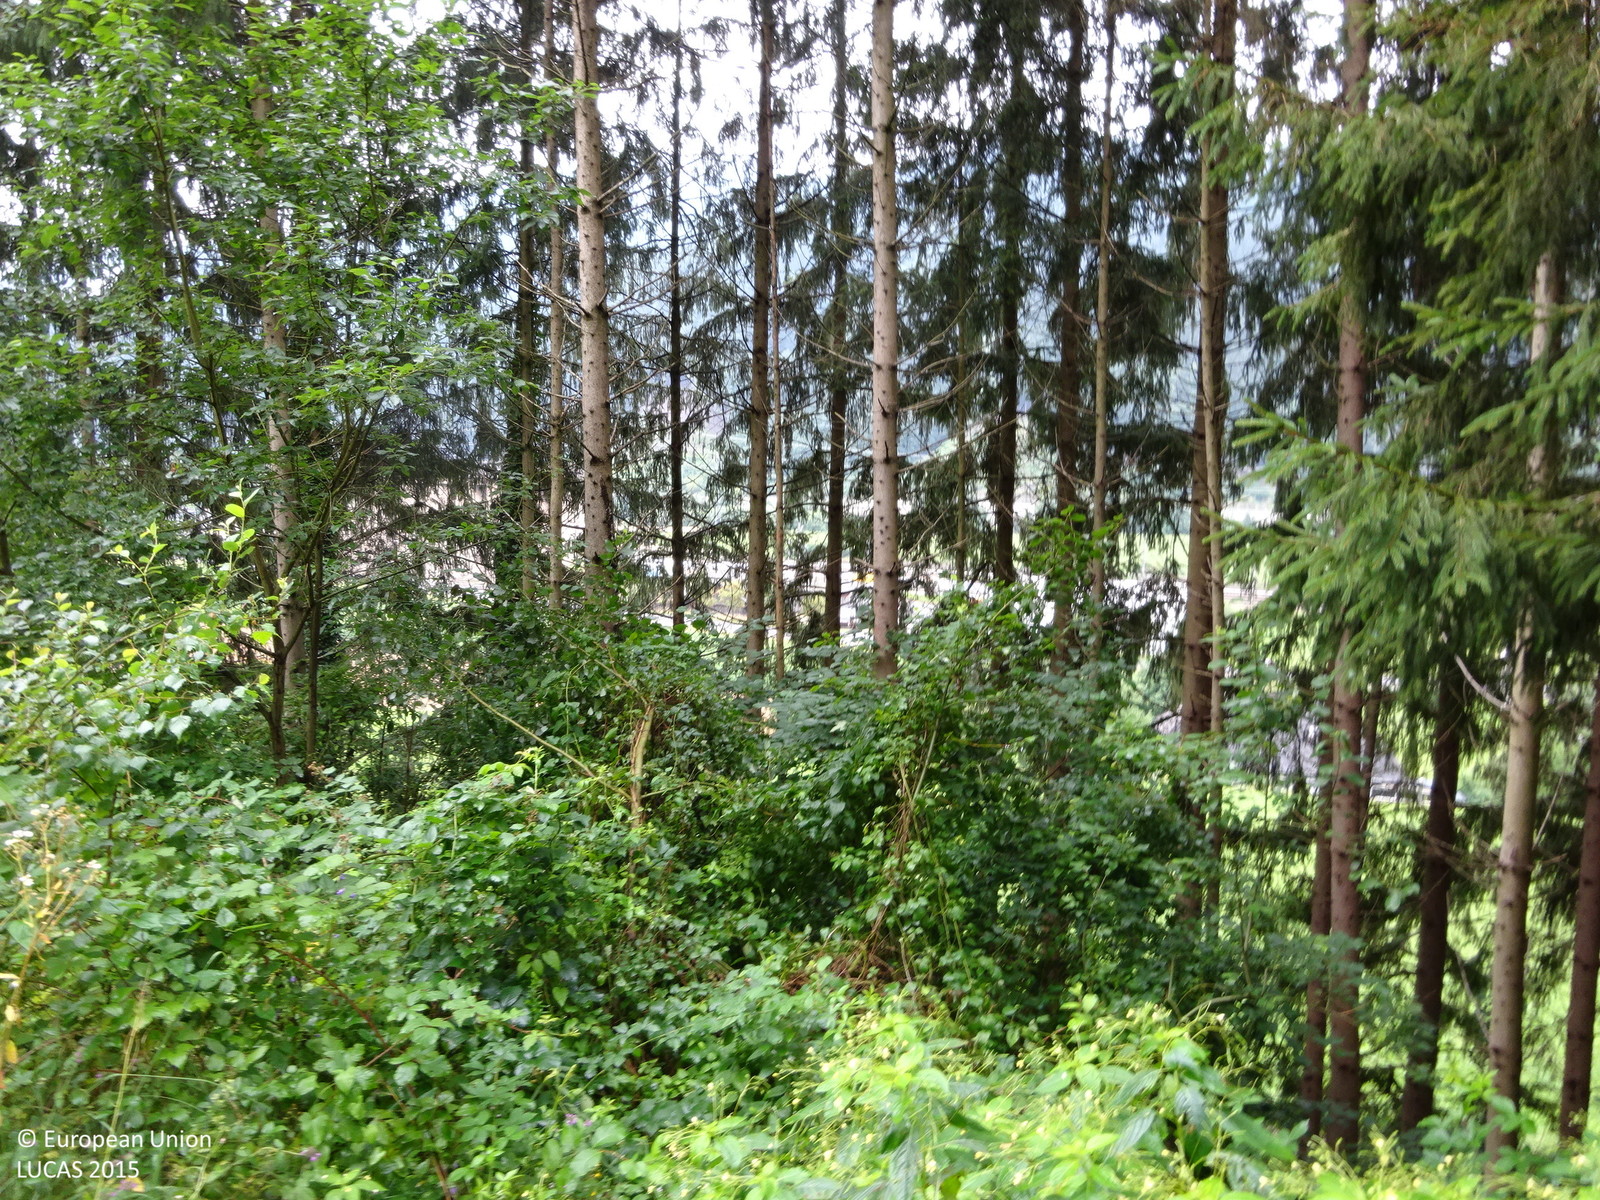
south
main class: Grassland
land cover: Spontaneously vegetated surfaces
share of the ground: > 75 %
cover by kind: herbaceous plants 100 %
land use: Forestry
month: July
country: AT
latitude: 47.3356
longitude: 15.3601
